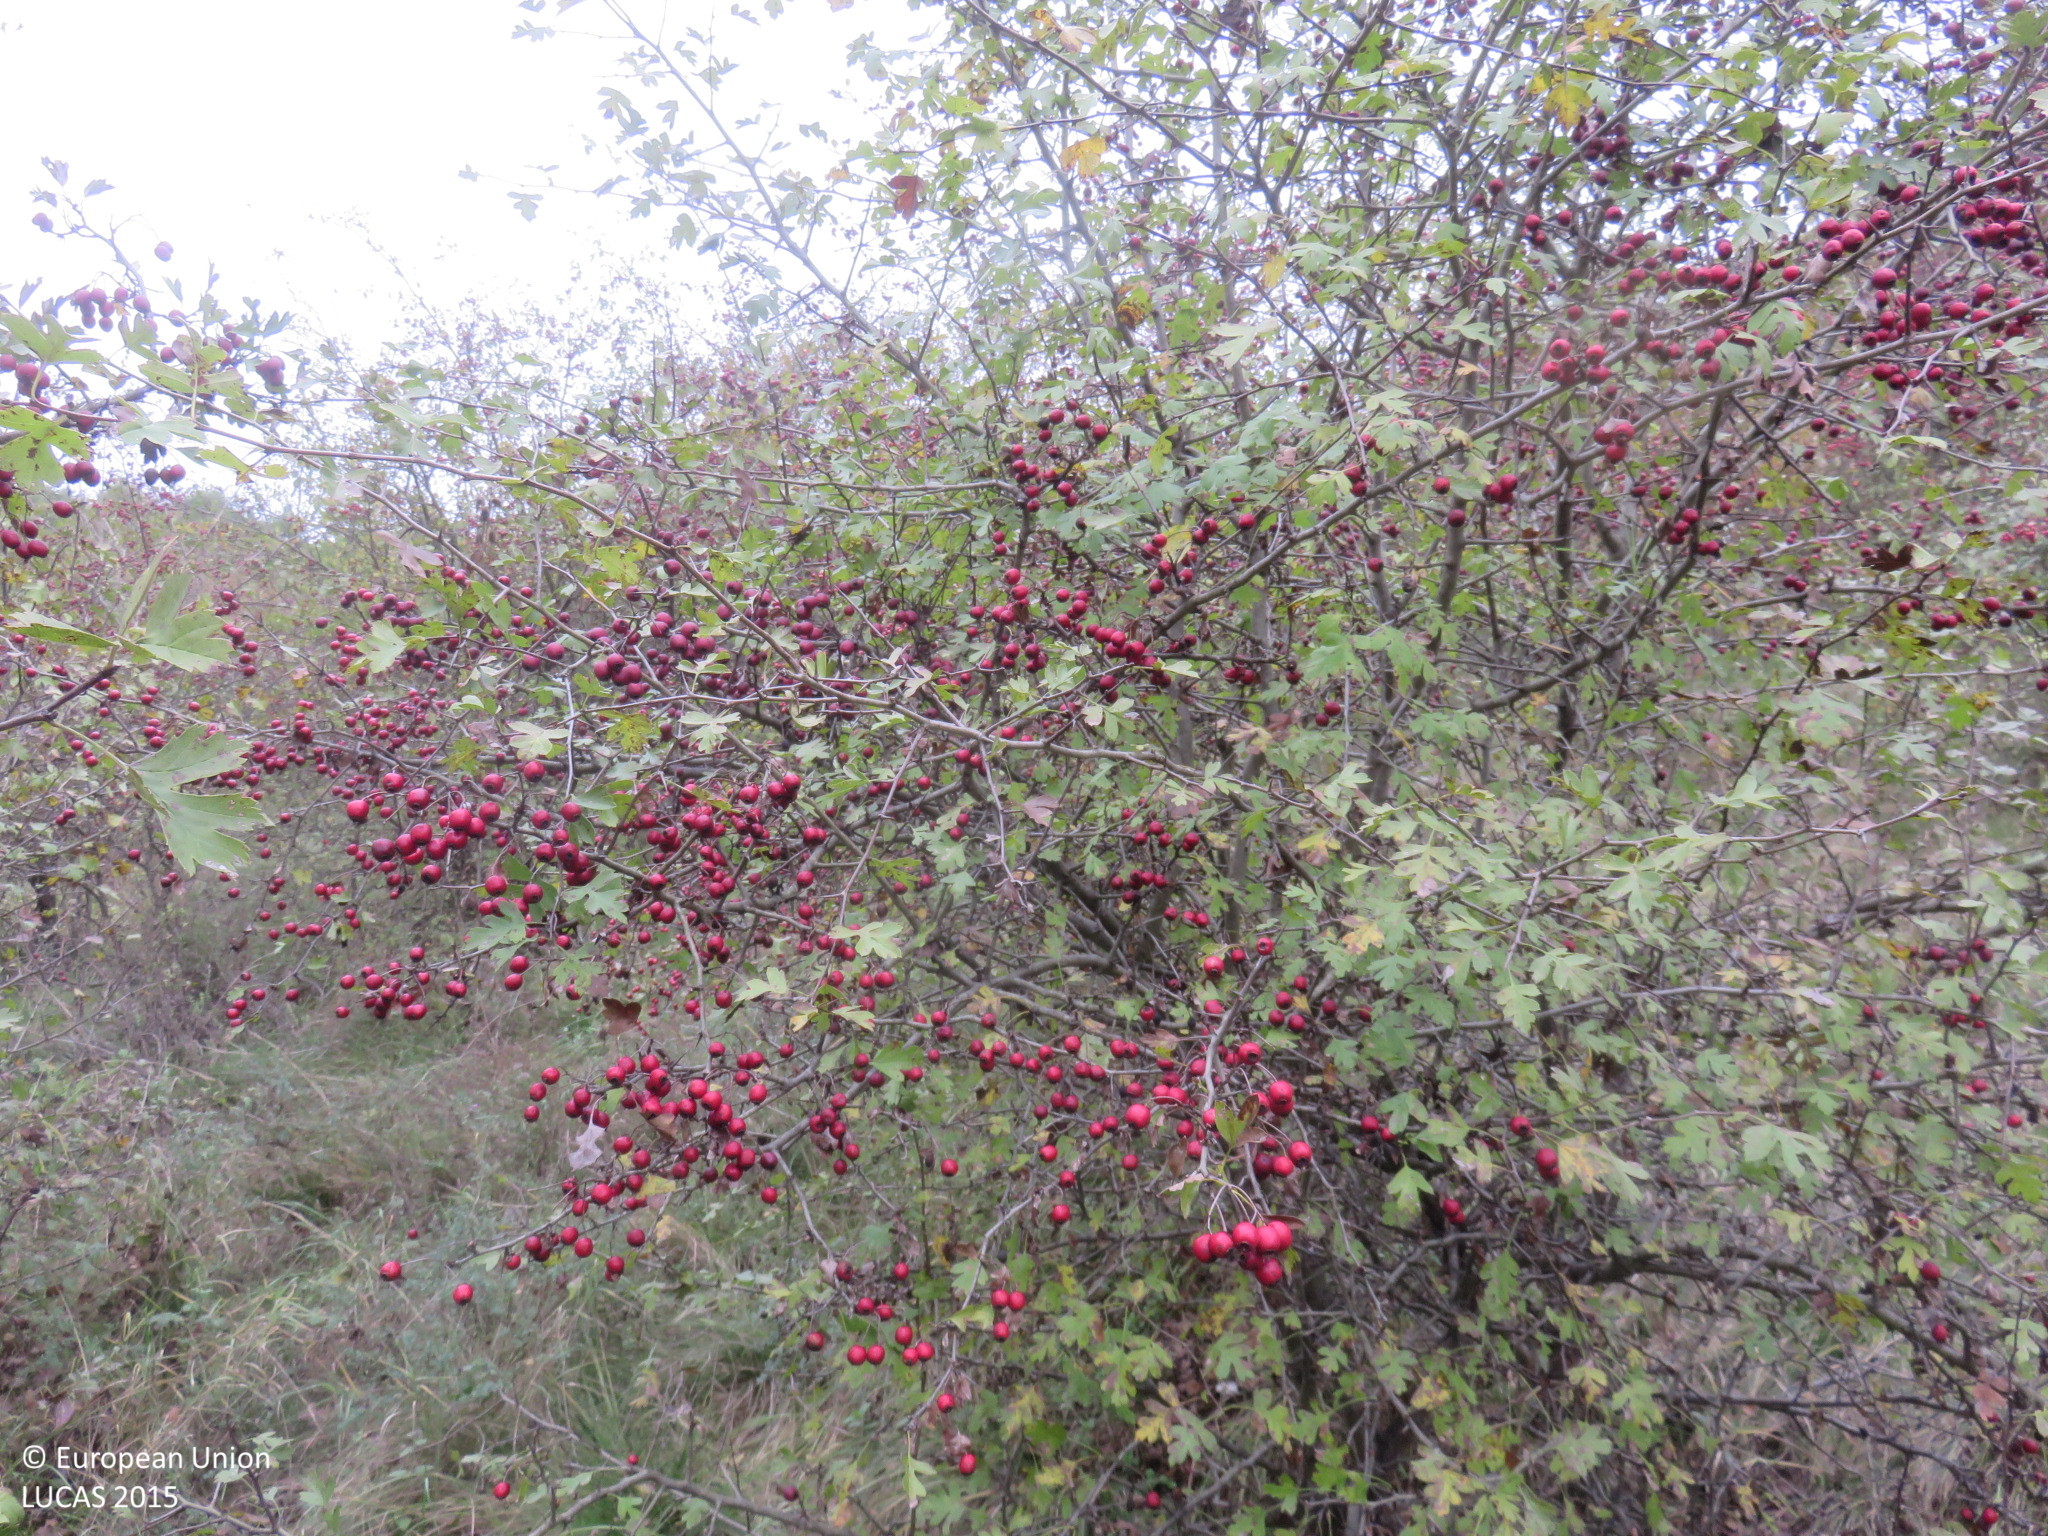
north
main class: Shrubland
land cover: Shrubland with sparse tree cover
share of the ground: > 75 %
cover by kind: shrubs 90 %, broadleaved forest trees 5 %, herbaceous plants 5 %
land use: Semi-natural and natural areas not in use
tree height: < 5 m
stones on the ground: < 10 %
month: October
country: BG
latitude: 43.0353
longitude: 25.2289
